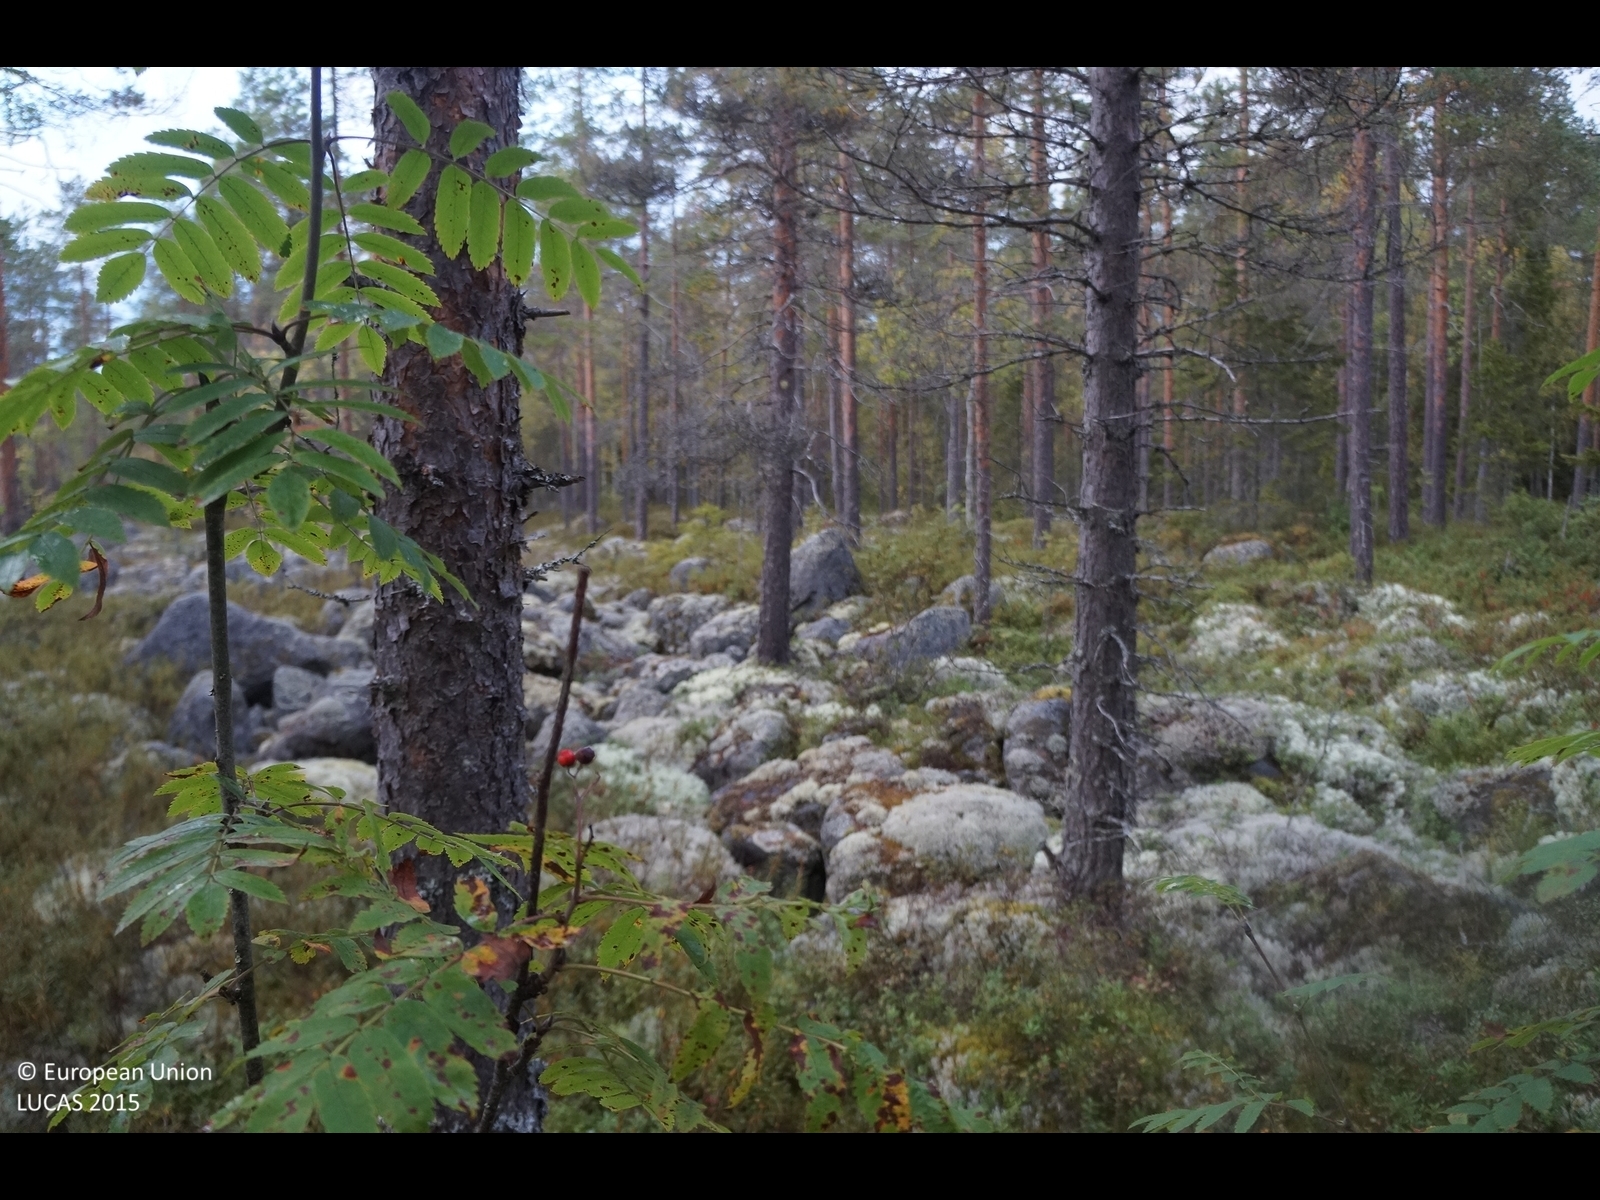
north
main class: Woodland
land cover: Pine dominated coniferous woodland
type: boreal forest
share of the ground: 50 - 75 %
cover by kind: coniferous forest trees 50 %, shrubs 20 %, lichens and mosses 15 %, consolidated bare surface 15 %
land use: Forestry
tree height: > 5 m
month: September
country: FI
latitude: 63.8991
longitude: 24.4371
